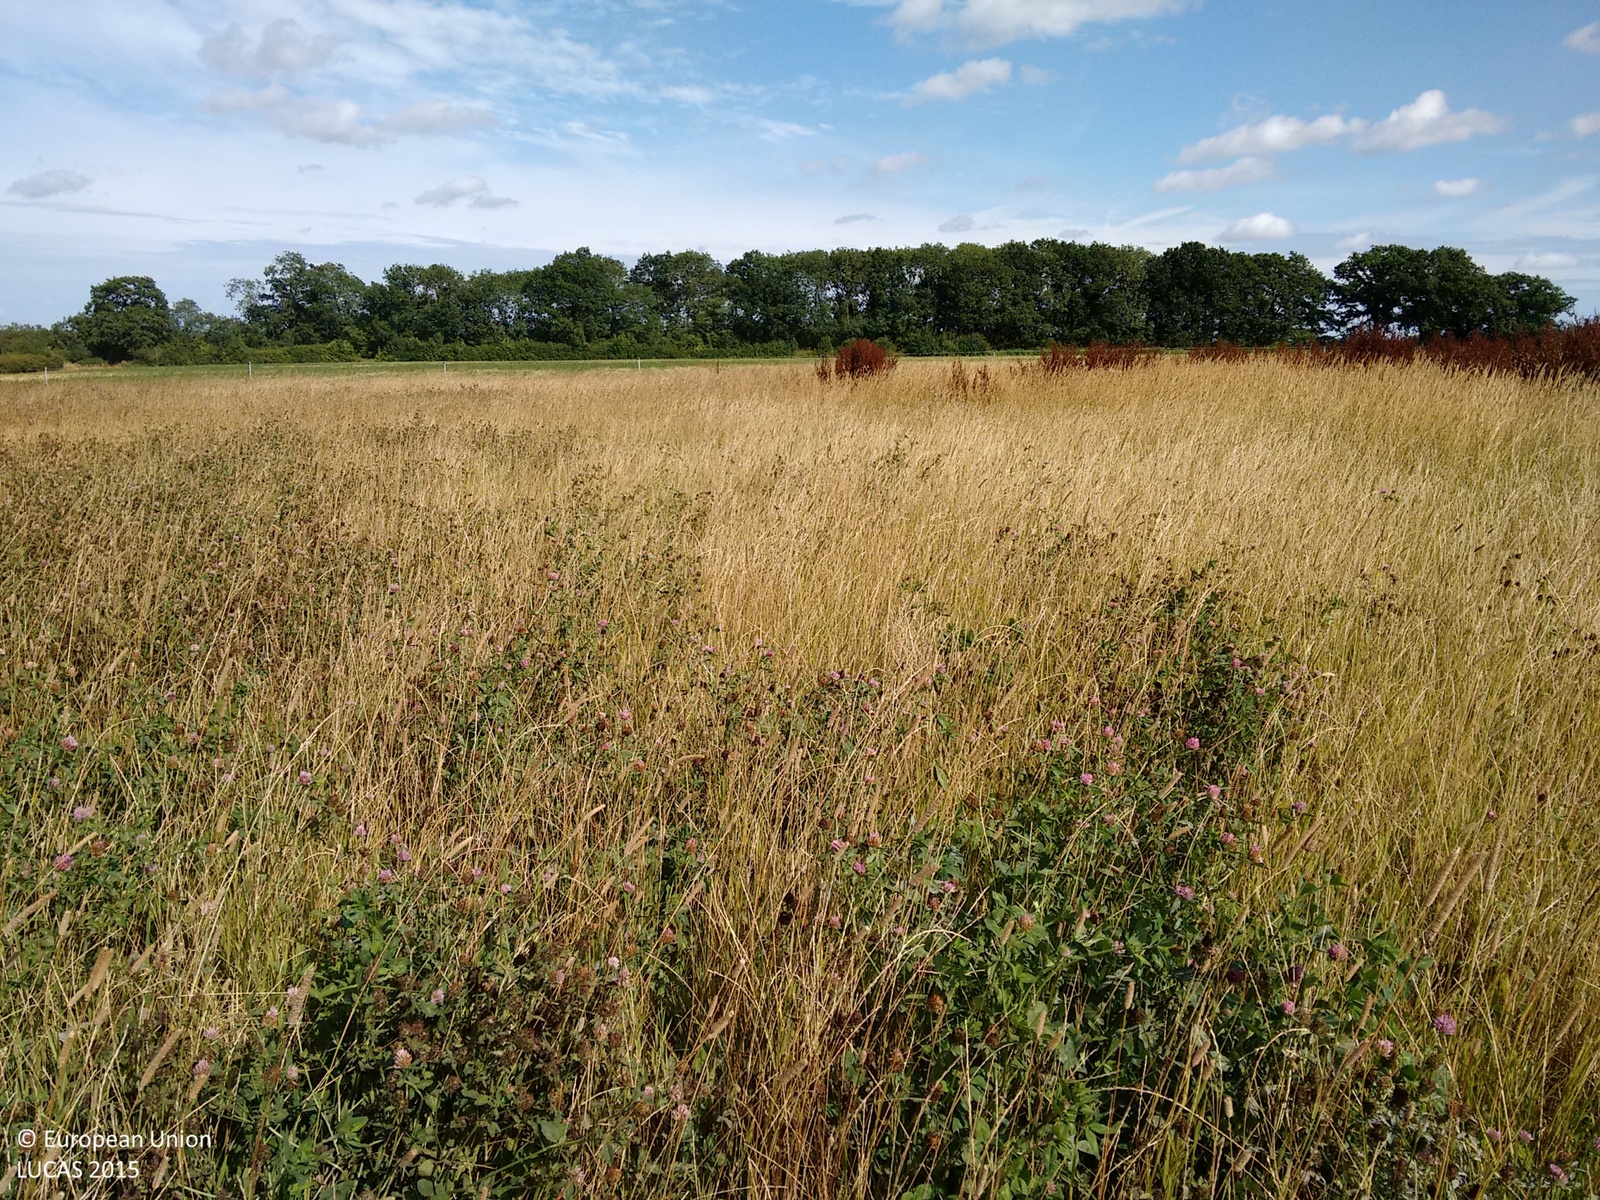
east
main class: Grassland
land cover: Grassland without tree/shrub cover
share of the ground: > 75 %
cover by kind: herbaceous plants 100 %
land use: Agriculture (excluding fallow land and kitchen gardens)
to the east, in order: Grassland without tree/shrub cover; Fences; Grassland without tree/shrub cover; Ditches and canals; Managed hedges; Grass margins; Paved roads, cycling and walking lanes; Grass margins; Broadleaved woodland
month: August
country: GB
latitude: 52.7417
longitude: 0.7768
